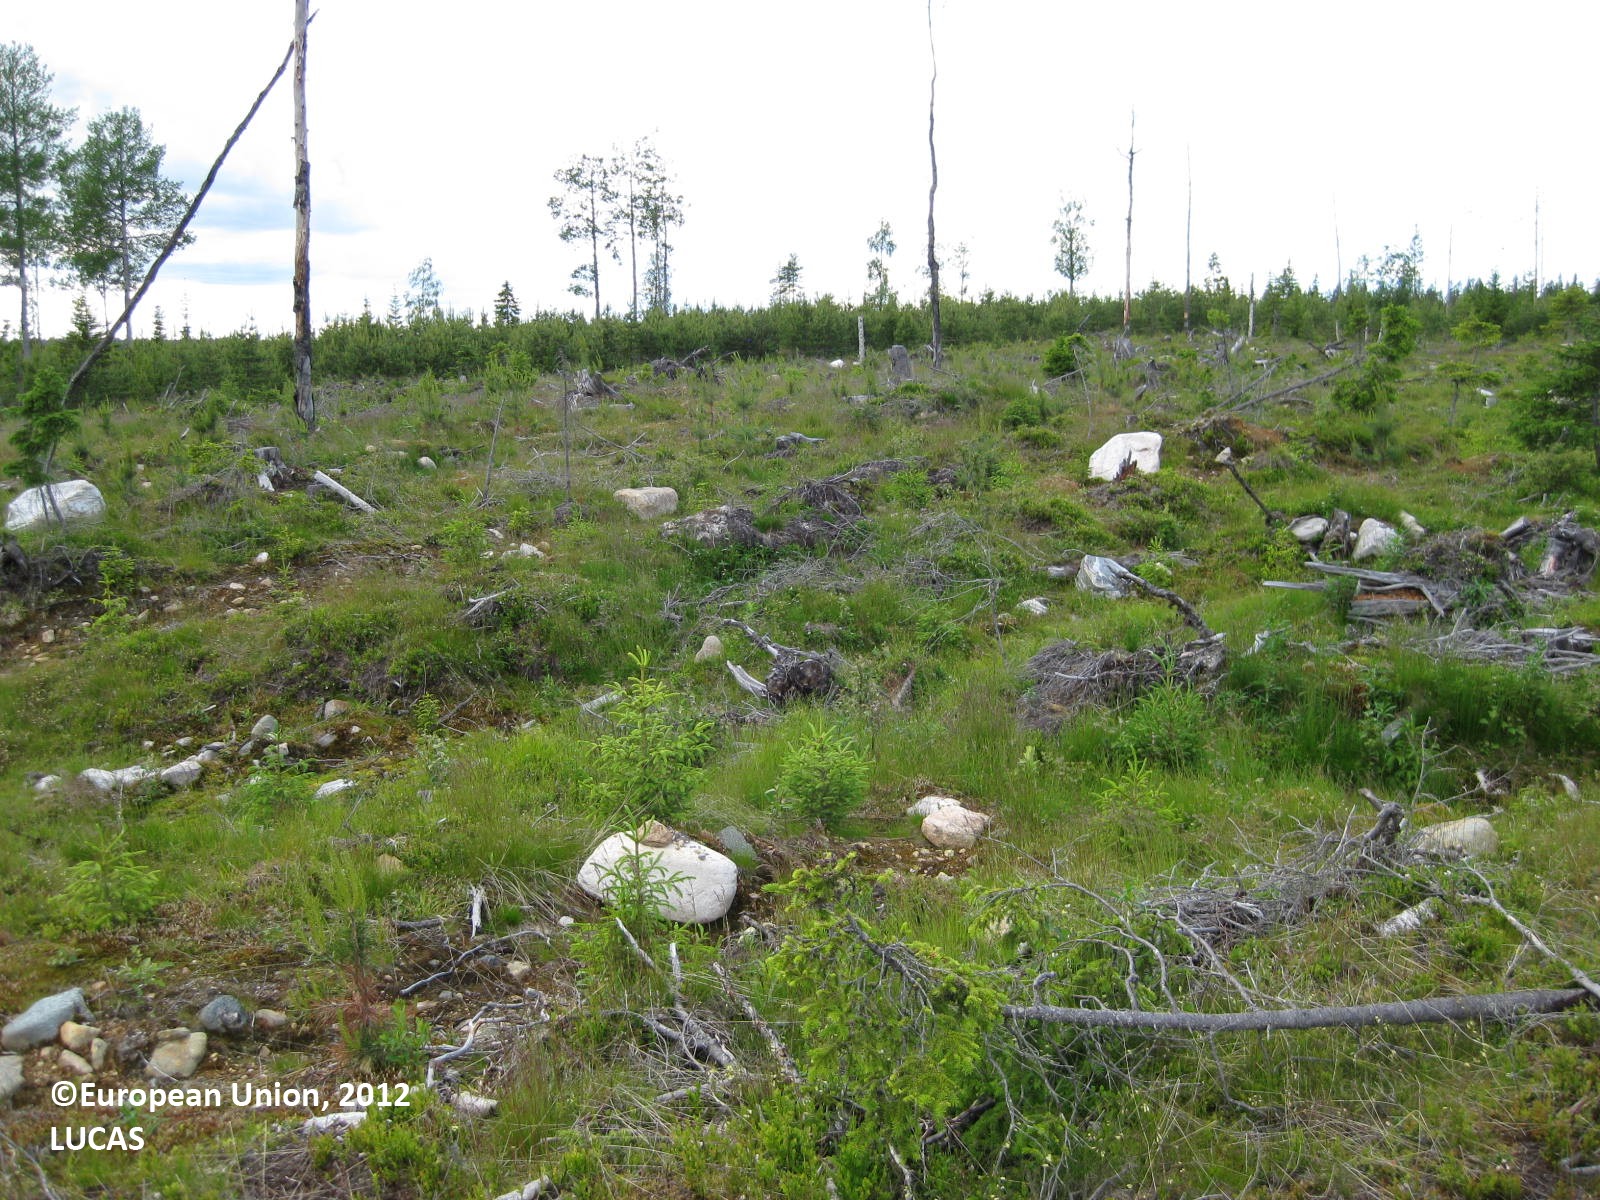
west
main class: Grassland
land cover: Grassland with sparse tree/shrub cover
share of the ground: > 75 %
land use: Forestry
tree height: < 5 m
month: July
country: FI
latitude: 65.5740
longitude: 29.4627
